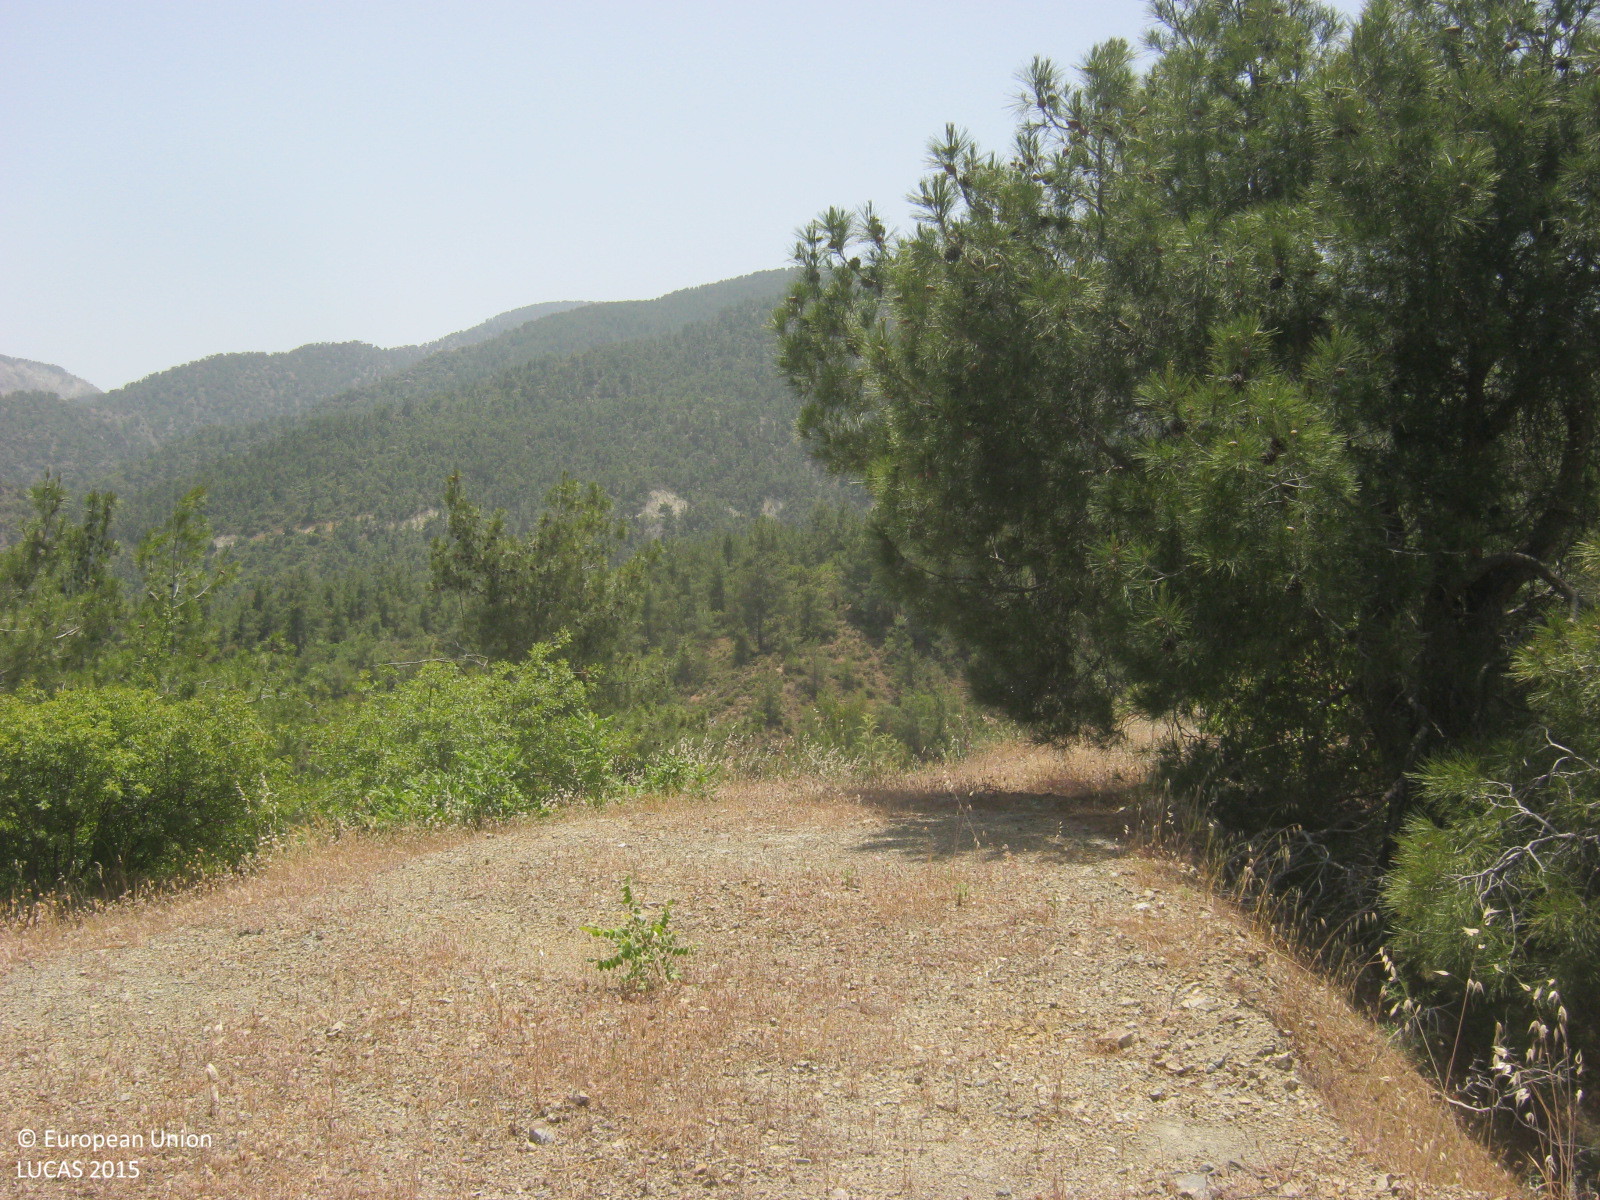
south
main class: Woodland
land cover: Pine dominated coniferous woodland
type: coniferous forest of the mediterranean region
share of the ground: > 75 %
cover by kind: coniferous forest trees 75 %, shrubs 15 %, unconsolidated bare surface 10 %
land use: Forestry
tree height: > 5 m
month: May
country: CY
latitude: 34.9932
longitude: 32.8805
